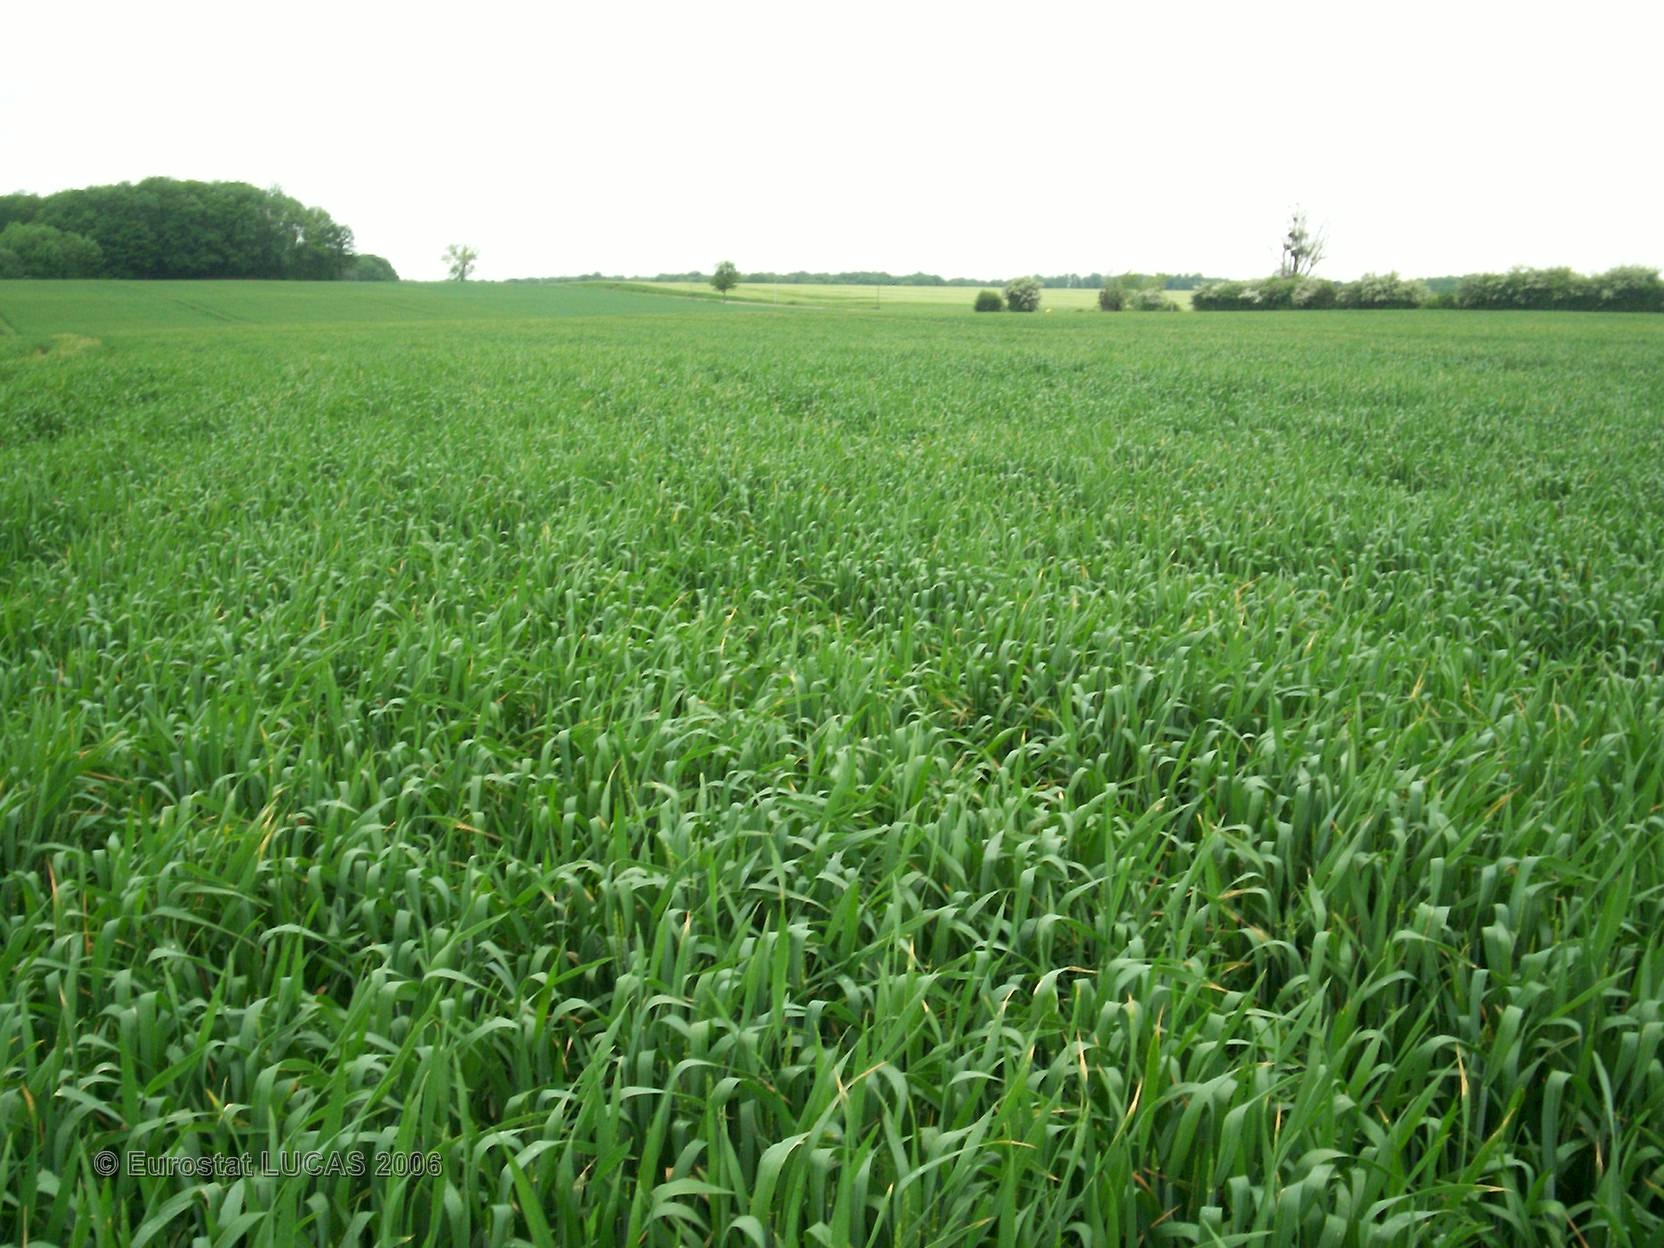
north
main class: Cropland
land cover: Common wheat
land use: Agriculture (excluding fallow land and kitchen gardens)
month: May
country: FR
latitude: 48.2467
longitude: 4.4627
